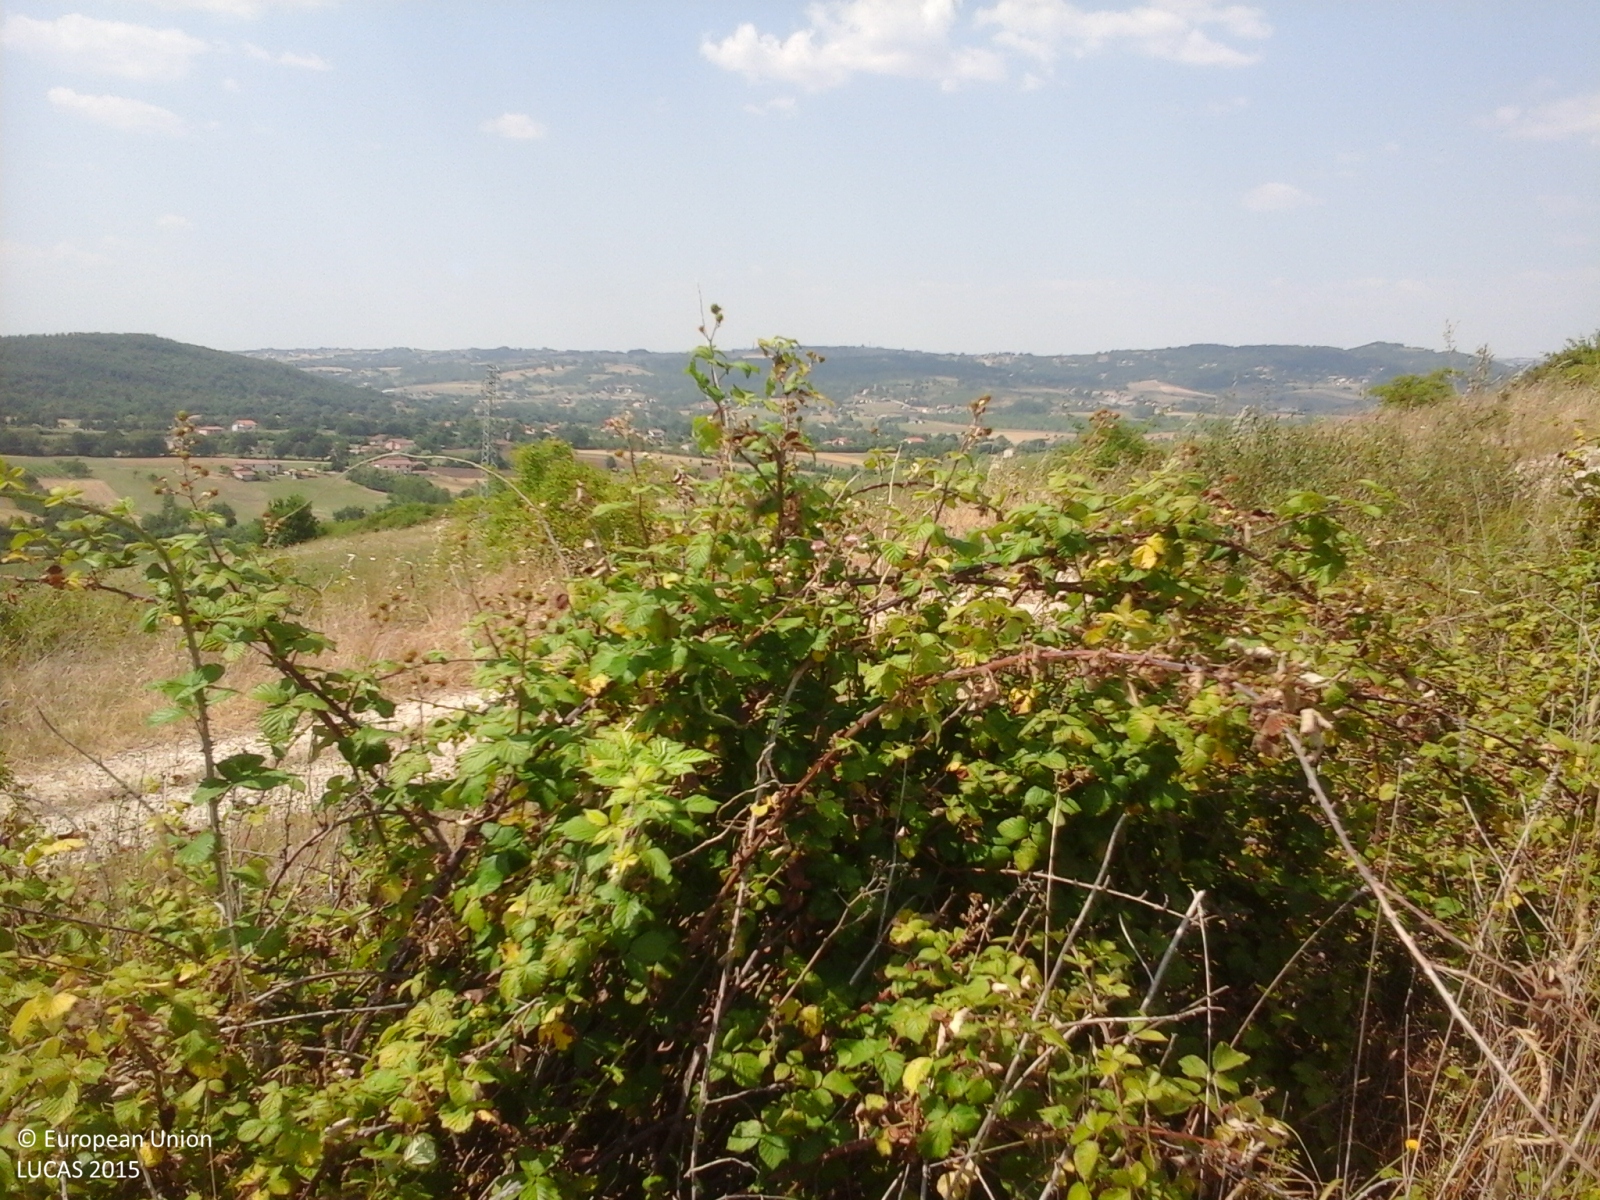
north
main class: Cropland
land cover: Lucerne
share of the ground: > 75 %
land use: Agriculture (excluding fallow land and kitchen gardens)
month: July
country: IT
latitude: 40.8757
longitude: 15.1418
